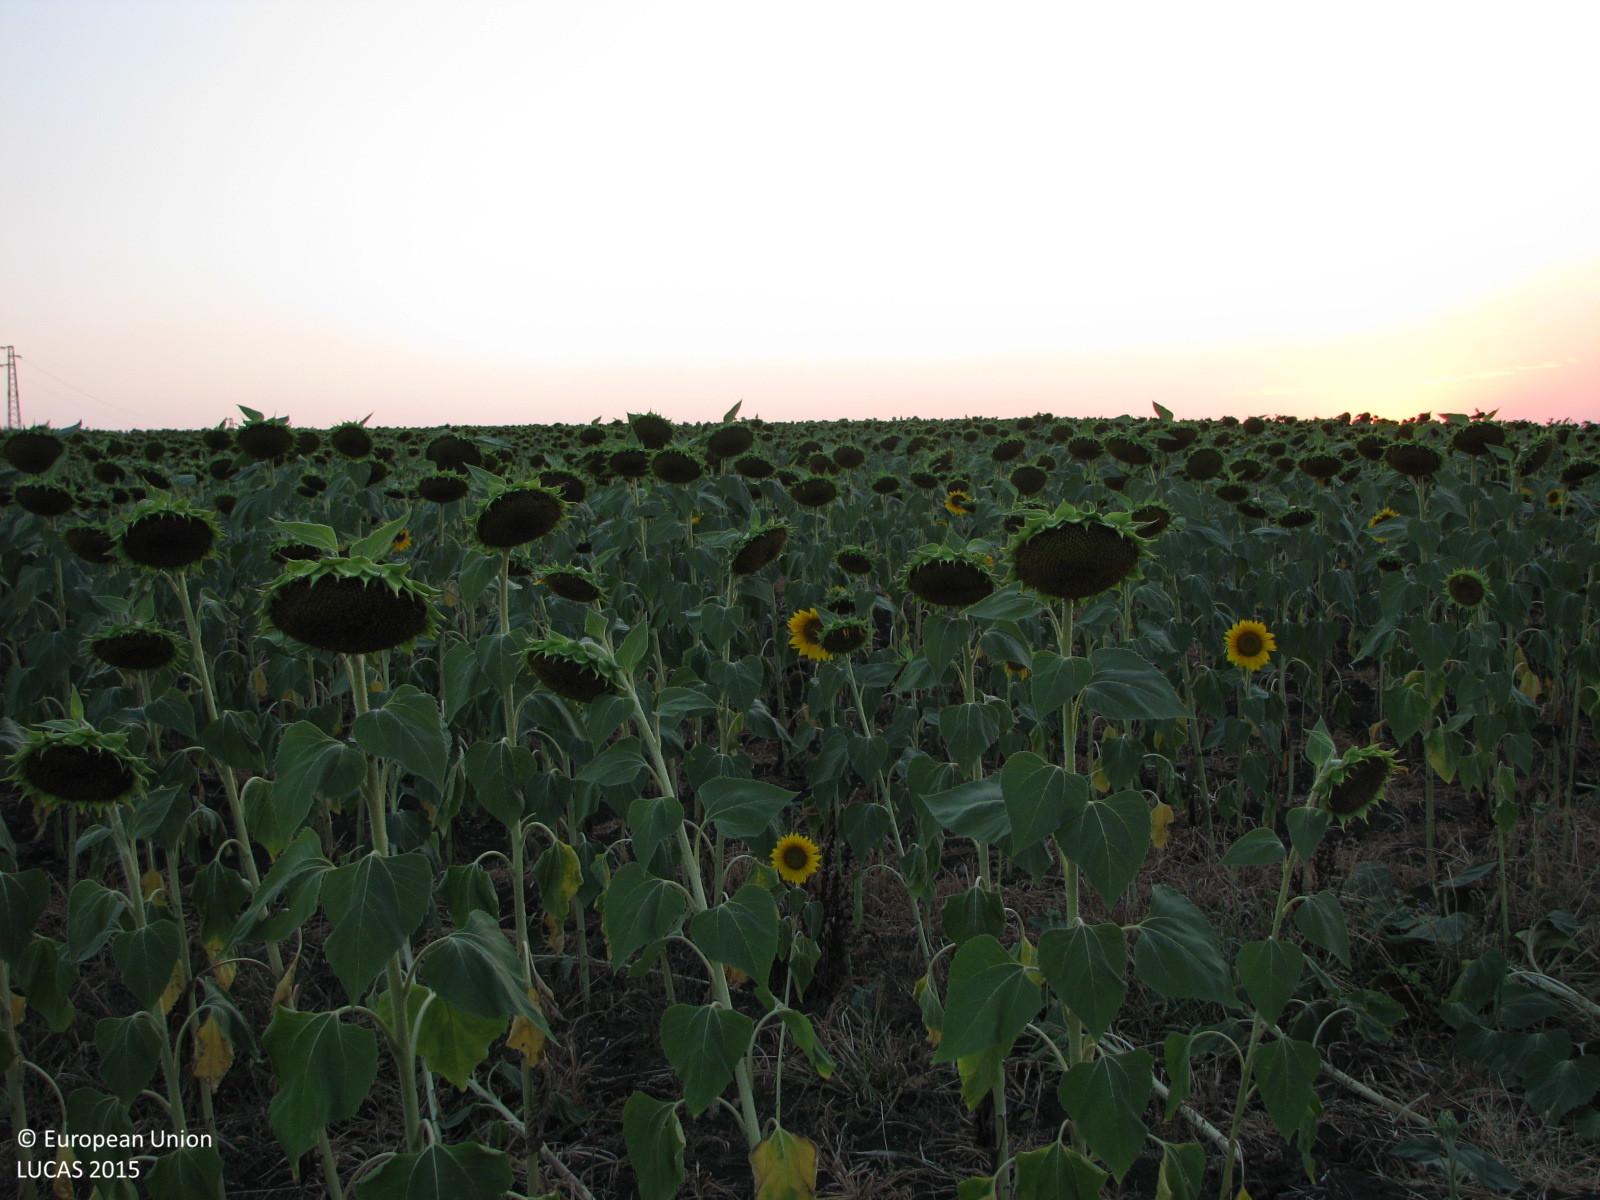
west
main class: Grassland
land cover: Grassland with sparse tree/shrub cover
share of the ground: > 75 %
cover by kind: herbaceous plants 90 %, broadleaved forest trees 5 %, shrubs 5 %
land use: Semi-natural and natural areas not in use
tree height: > 5 m
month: August
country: BG
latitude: 42.4786
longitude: 26.6514
